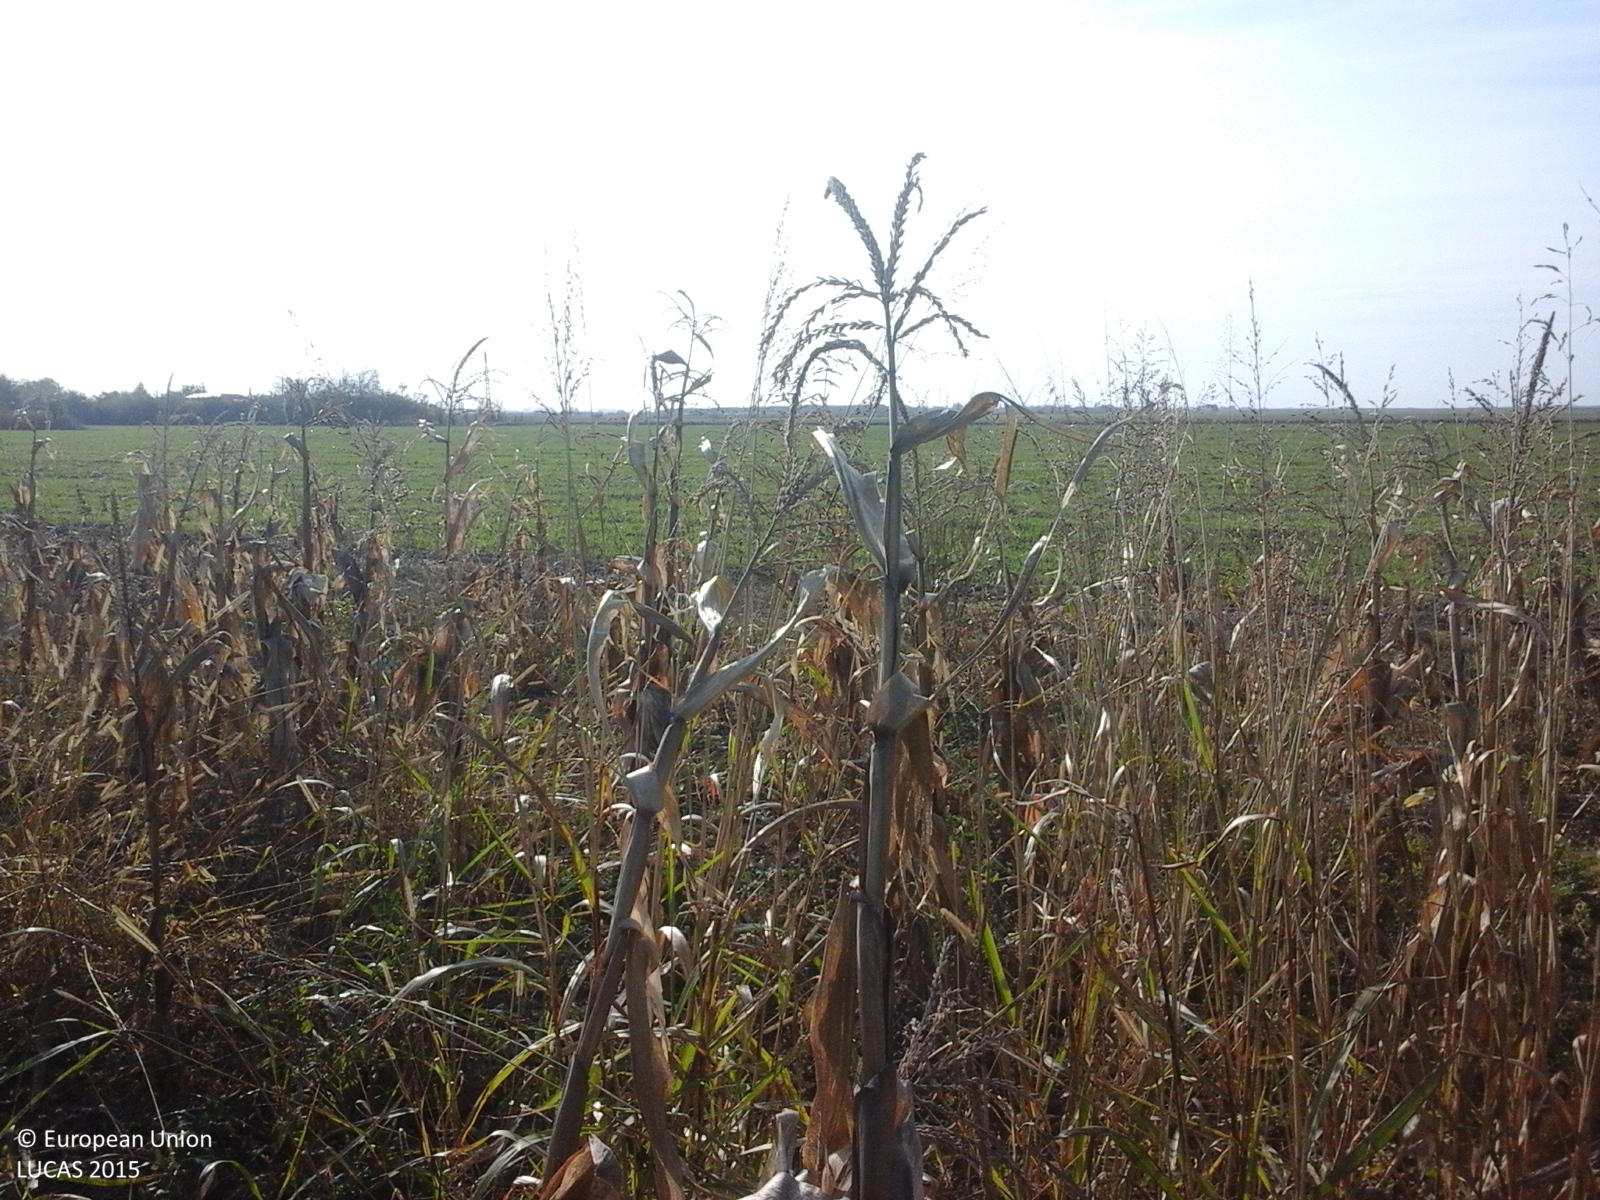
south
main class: Cropland
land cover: Maize
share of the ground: > 75 %
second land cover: Spontaneously vegetated surfaces
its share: 50 - 75 %
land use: Agriculture (excluding fallow land and kitchen gardens)
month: October
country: RO
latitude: 45.4793
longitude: 27.3029
